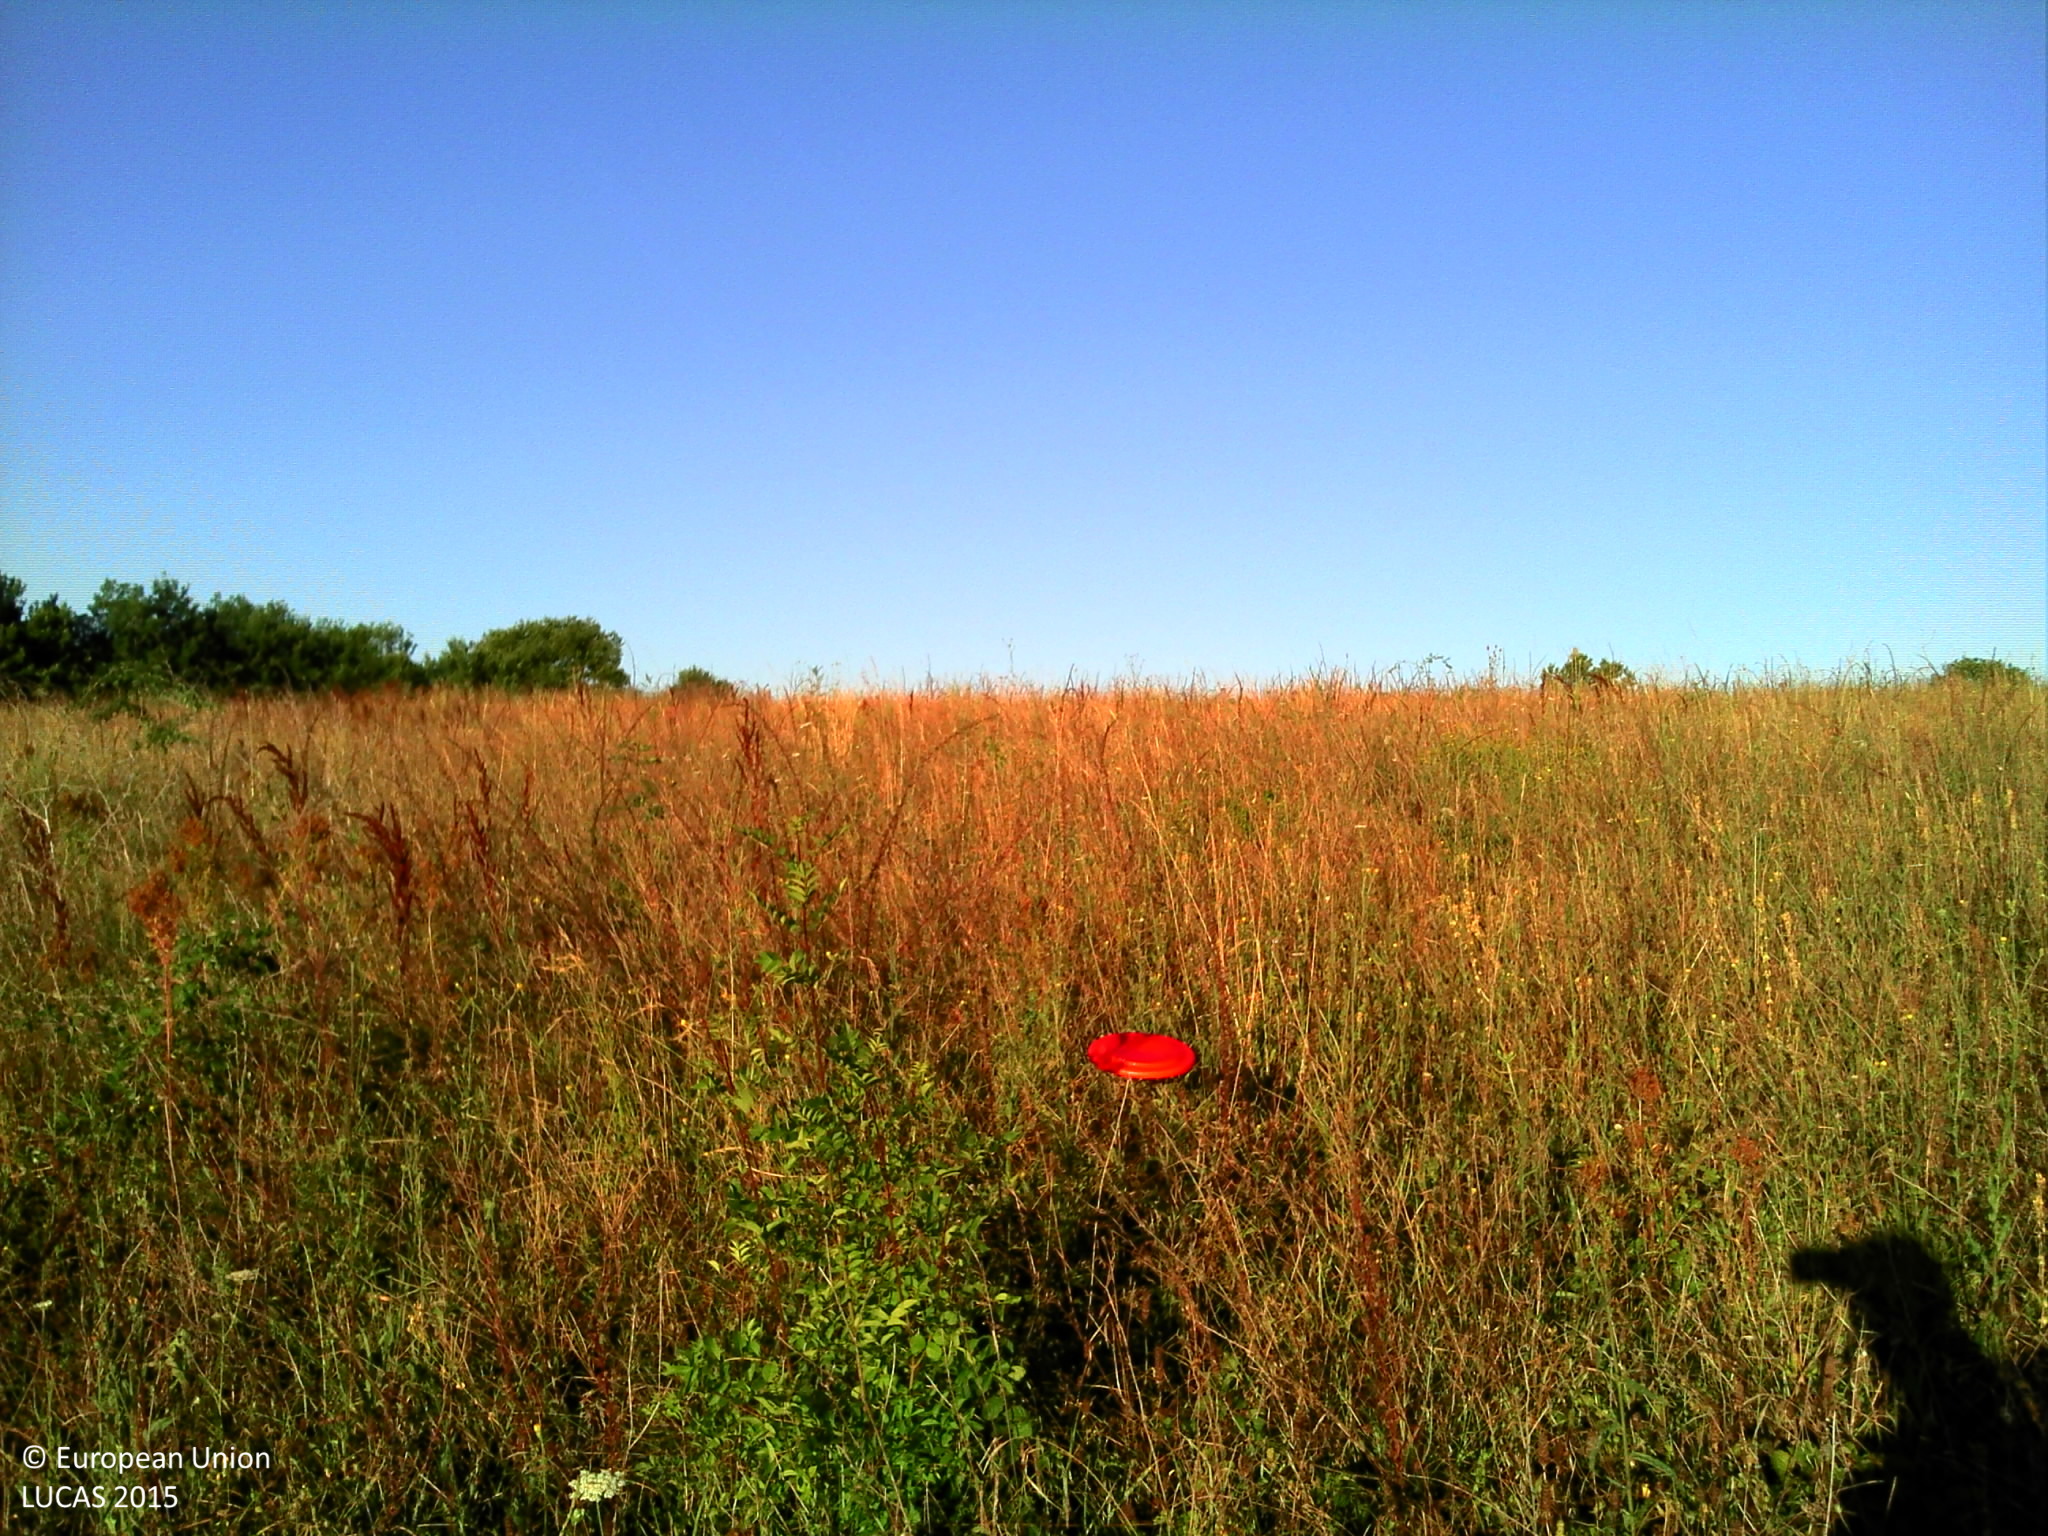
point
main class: Grassland
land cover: Spontaneously vegetated surfaces
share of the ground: > 75 %
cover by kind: herbaceous plants 85 %, lichens and mosses 10 %, shrubs 5 %
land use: Semi-natural and natural areas not in use
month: July
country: FR
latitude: 44.6822
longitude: 0.5673
